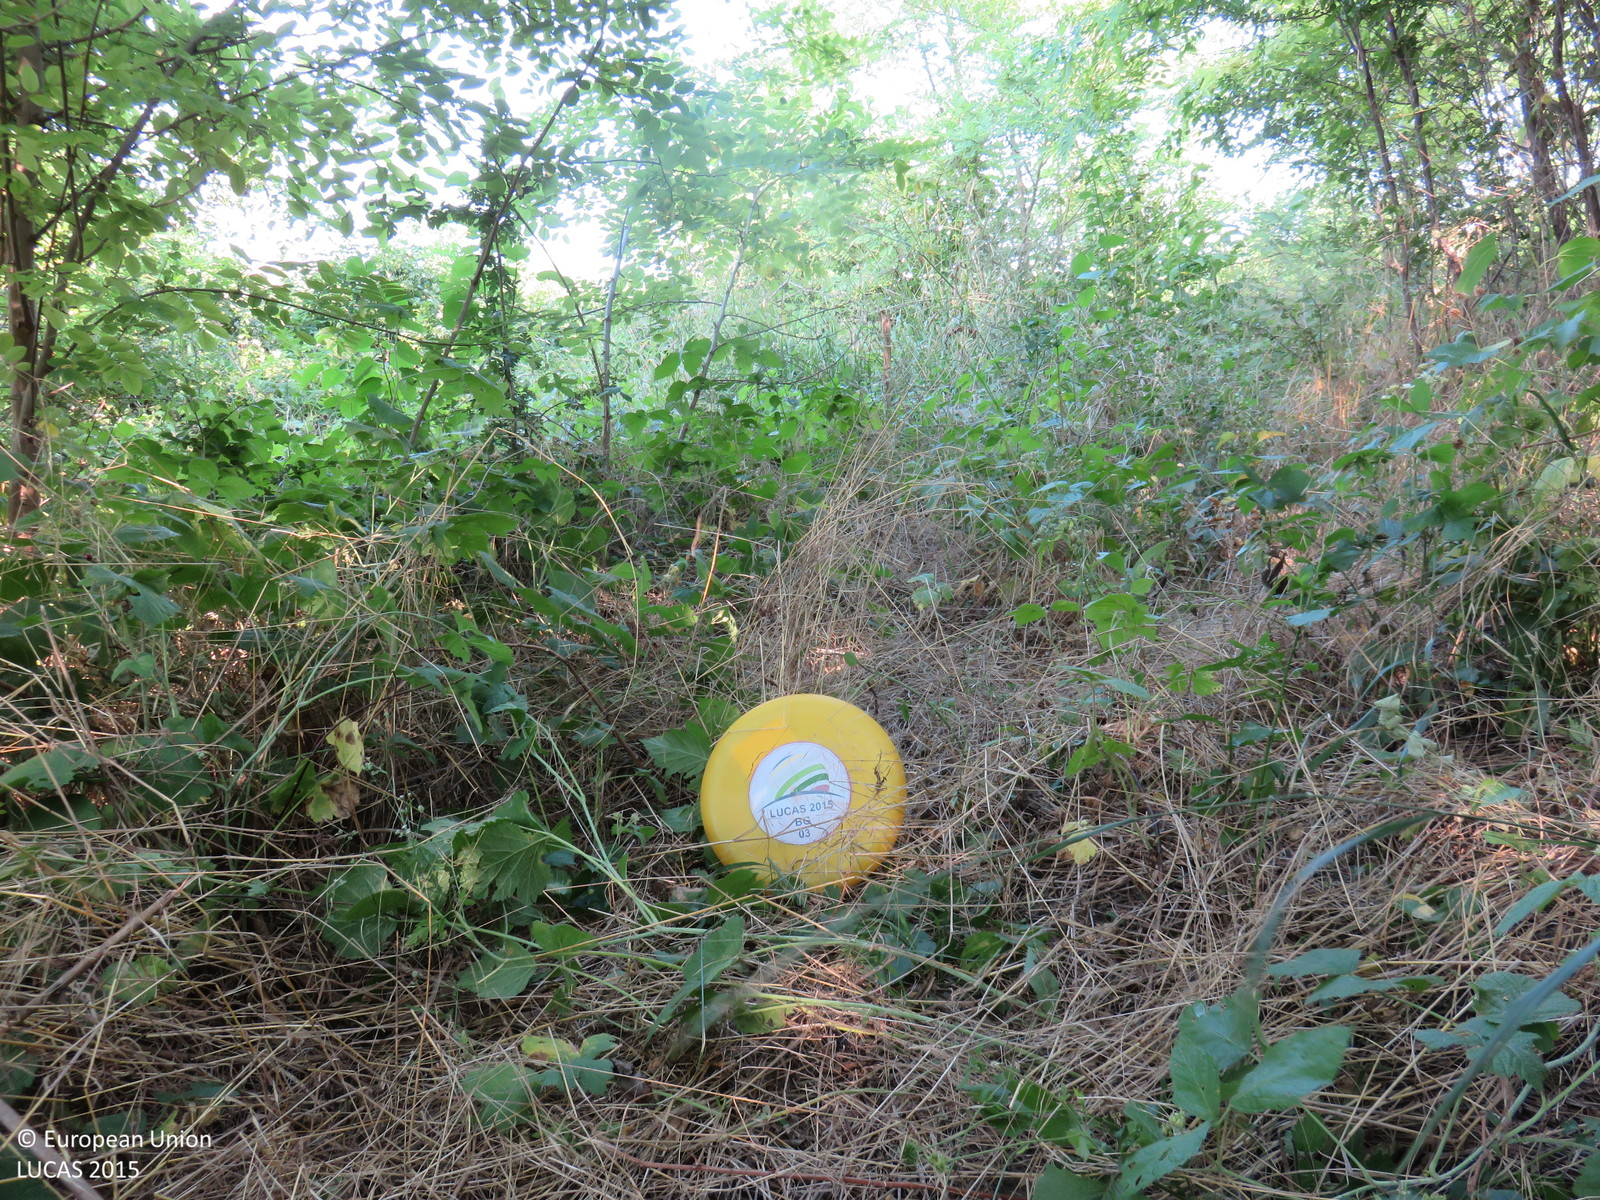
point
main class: Woodland
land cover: Broadleaved woodland
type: mesophytic deciduous forest
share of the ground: > 75 %
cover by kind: broadleaved forest trees 90 %, shrubs 5 %, herbaceous plants 5 %
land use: Forestry
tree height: < 5 m
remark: Clear cut
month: July
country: BG
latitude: 43.4880
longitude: 25.0208
